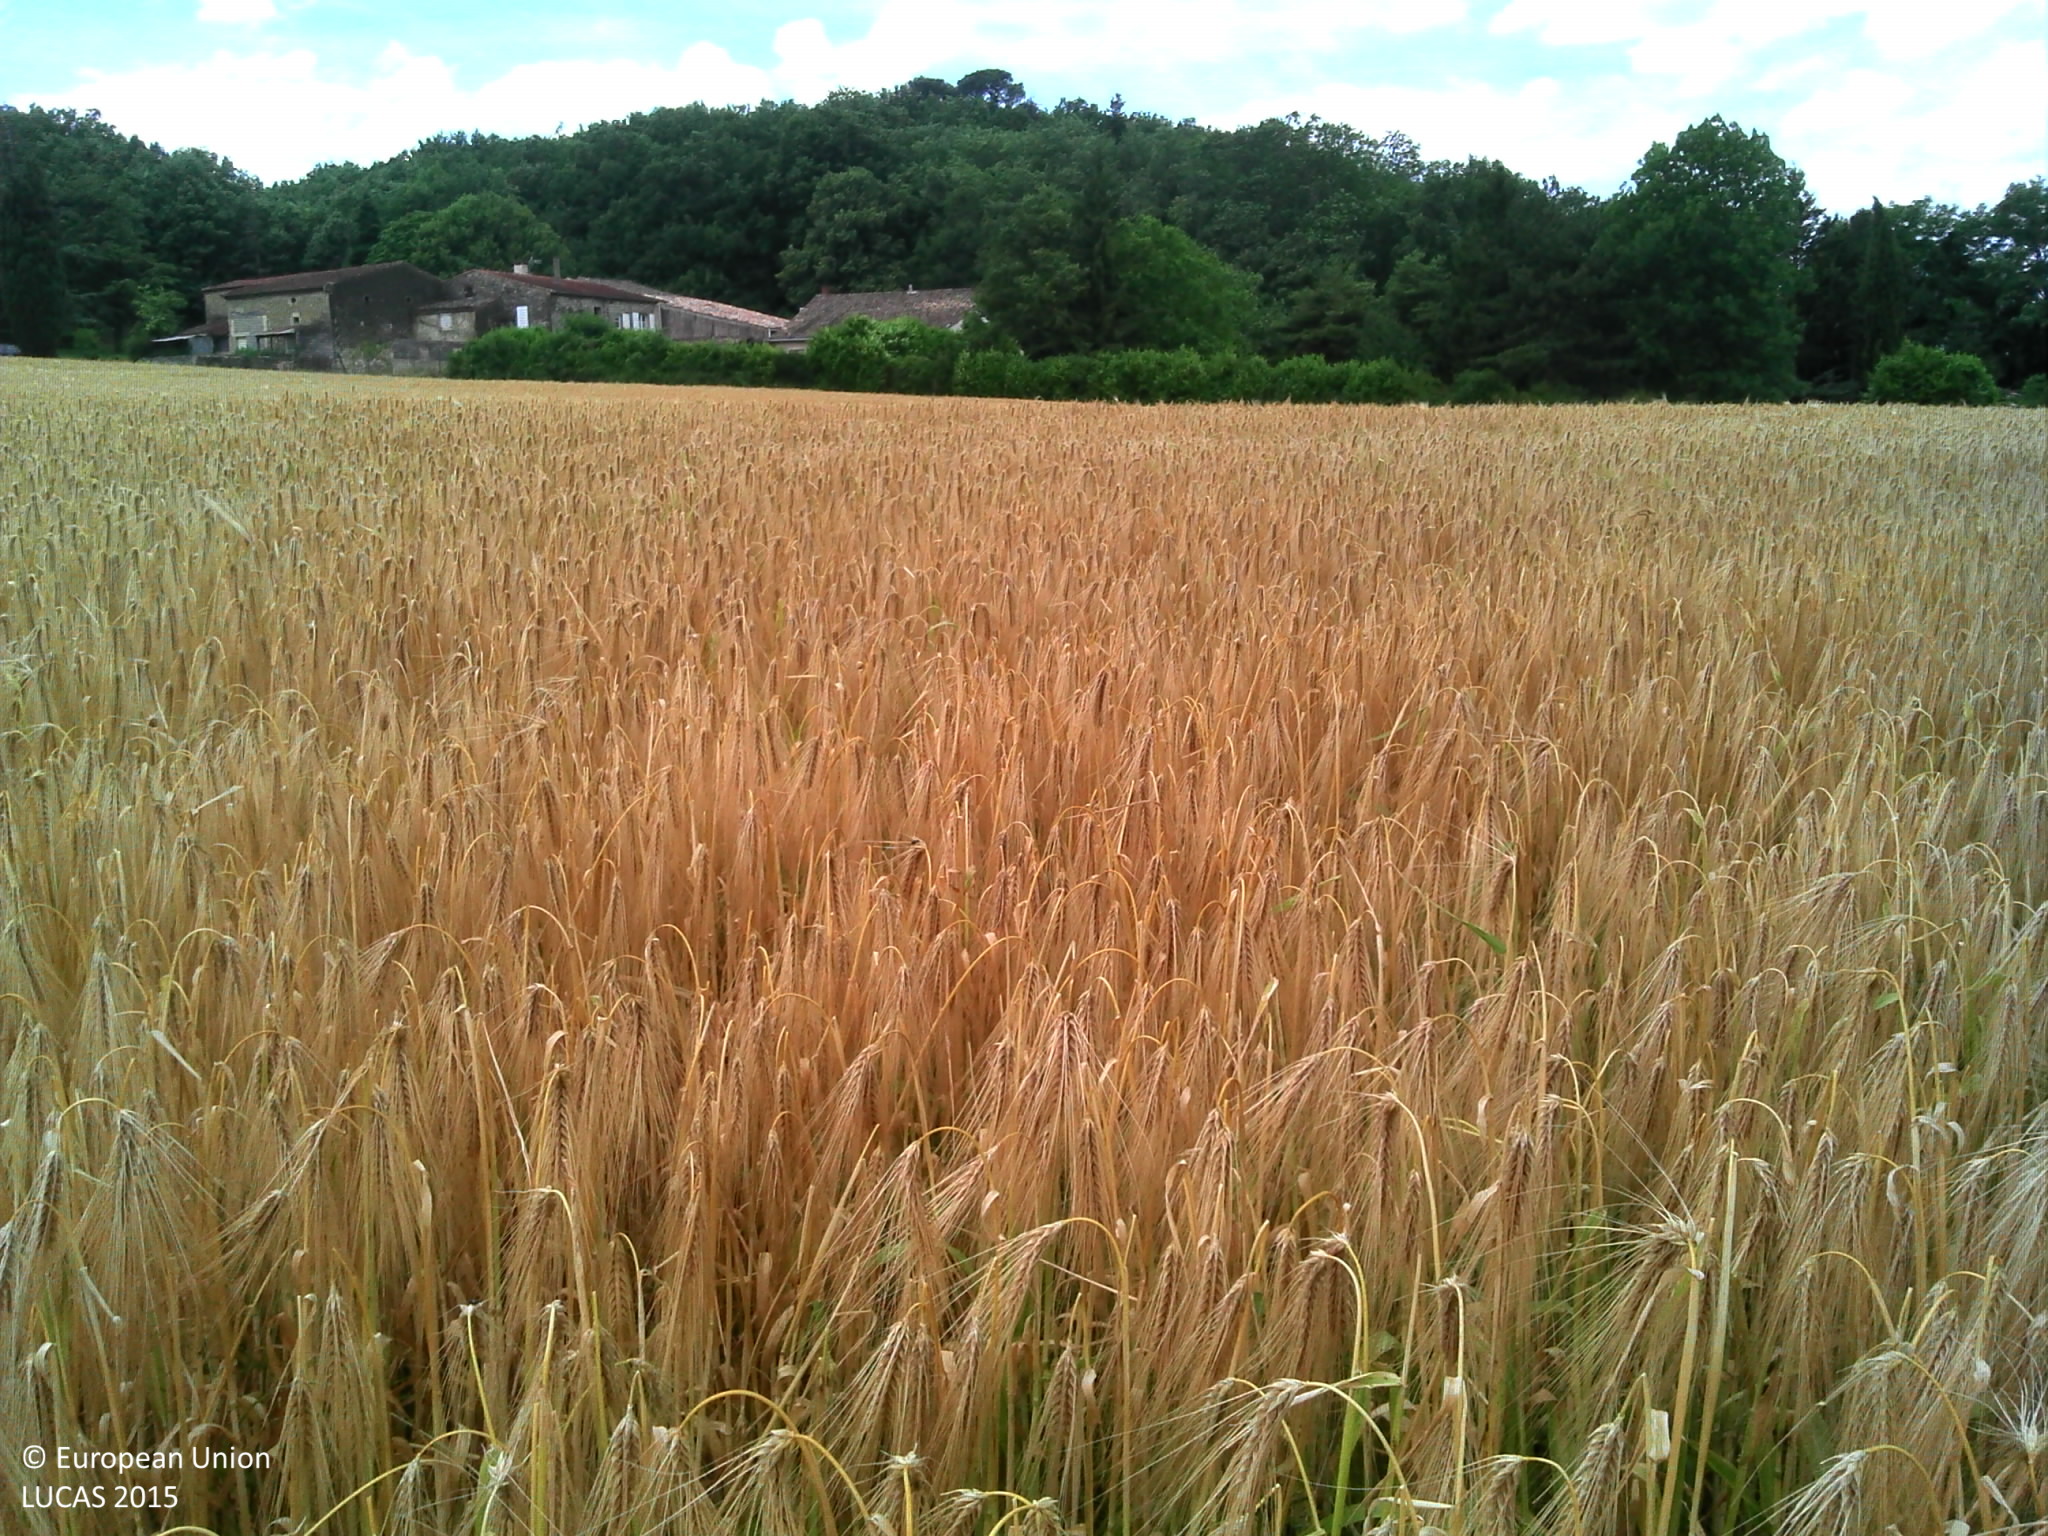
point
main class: Cropland
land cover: Barley
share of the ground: > 75 %
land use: Agriculture (excluding fallow land and kitchen gardens)
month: June
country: FR
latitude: 44.8279
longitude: 5.0354
